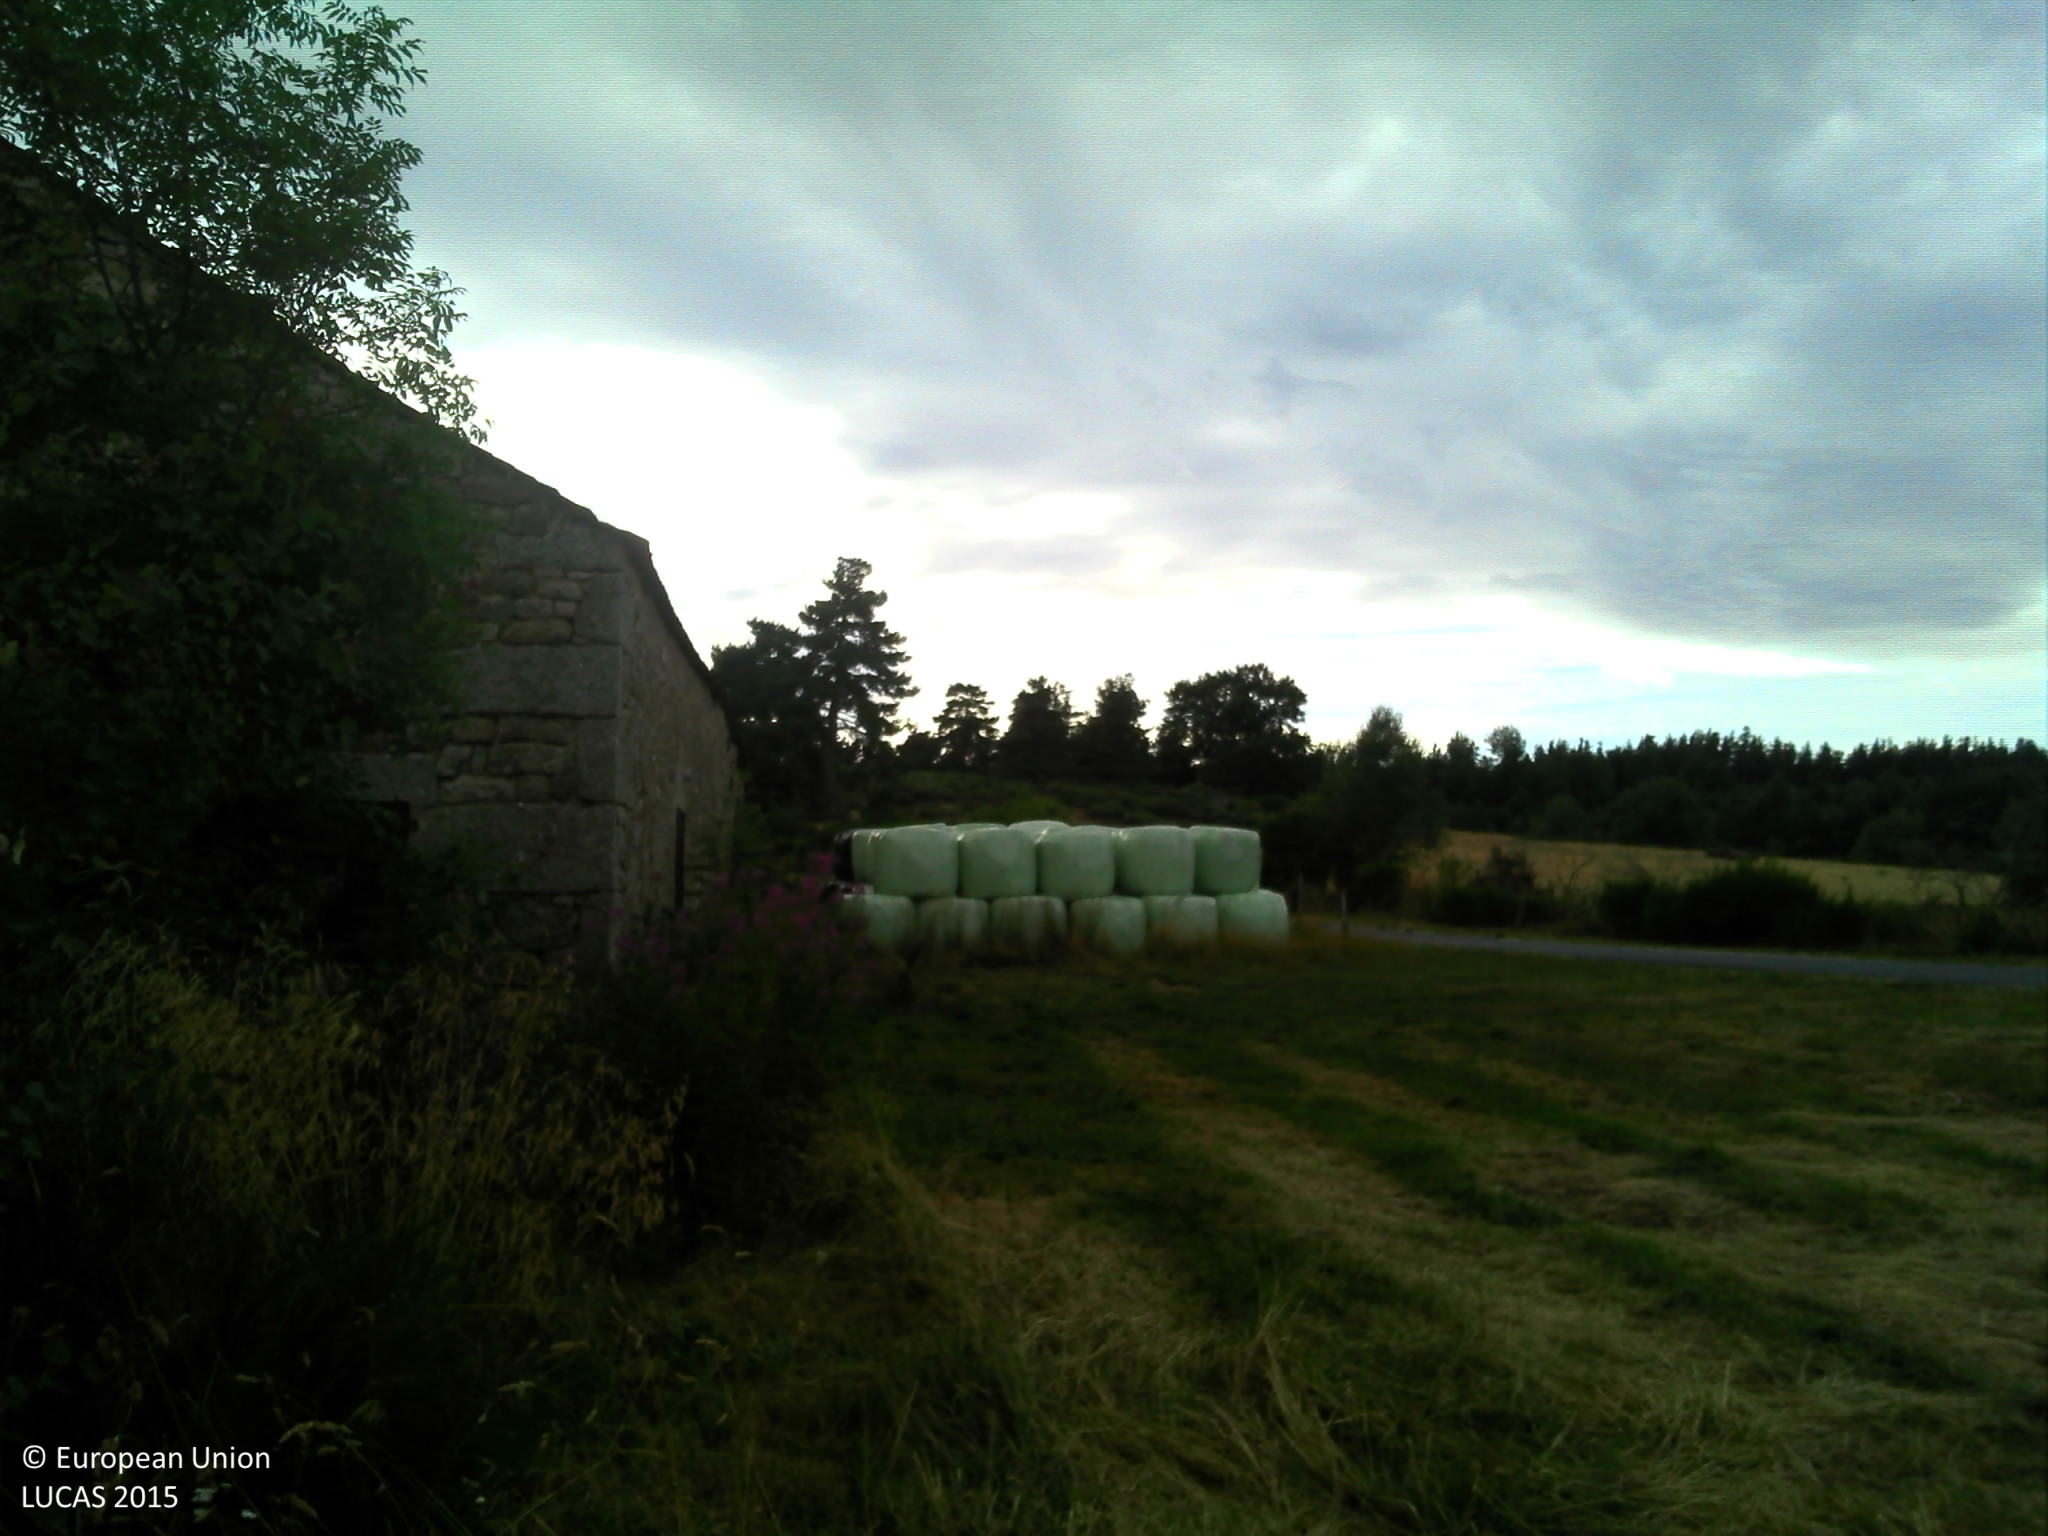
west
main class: Grassland
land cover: Grassland without tree/shrub cover
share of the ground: > 75 %
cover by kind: herbaceous plants 95 %, shrubs 5 %
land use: Agriculture (excluding fallow land and kitchen gardens)
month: July
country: FR
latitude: 44.8353
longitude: 3.2358
